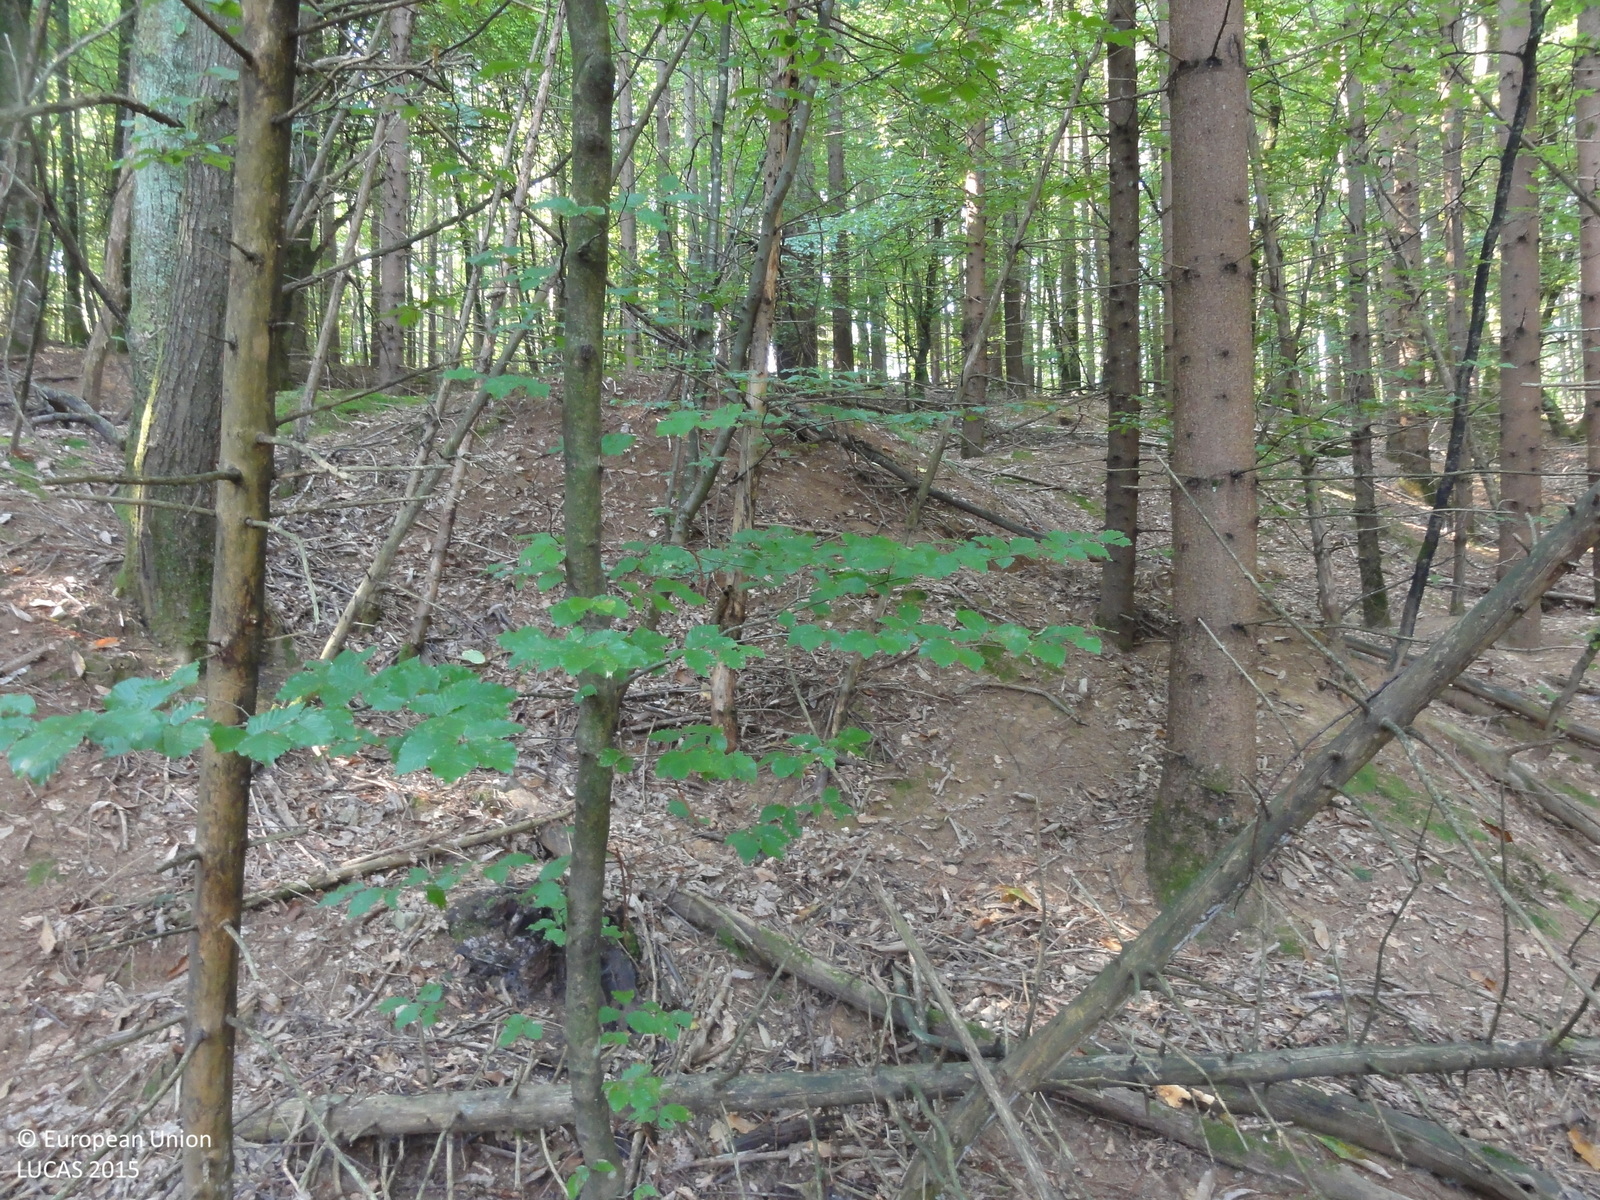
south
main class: Woodland
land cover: Spruce dominated mixed woodland
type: mountainous beech forest
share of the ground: > 75 %
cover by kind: coniferous forest trees 65 %, broadleaved forest trees 30 %, herbaceous plants 5 %
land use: Forestry
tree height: > 5 m
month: August
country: SI
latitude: 45.8897
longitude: 15.0354
